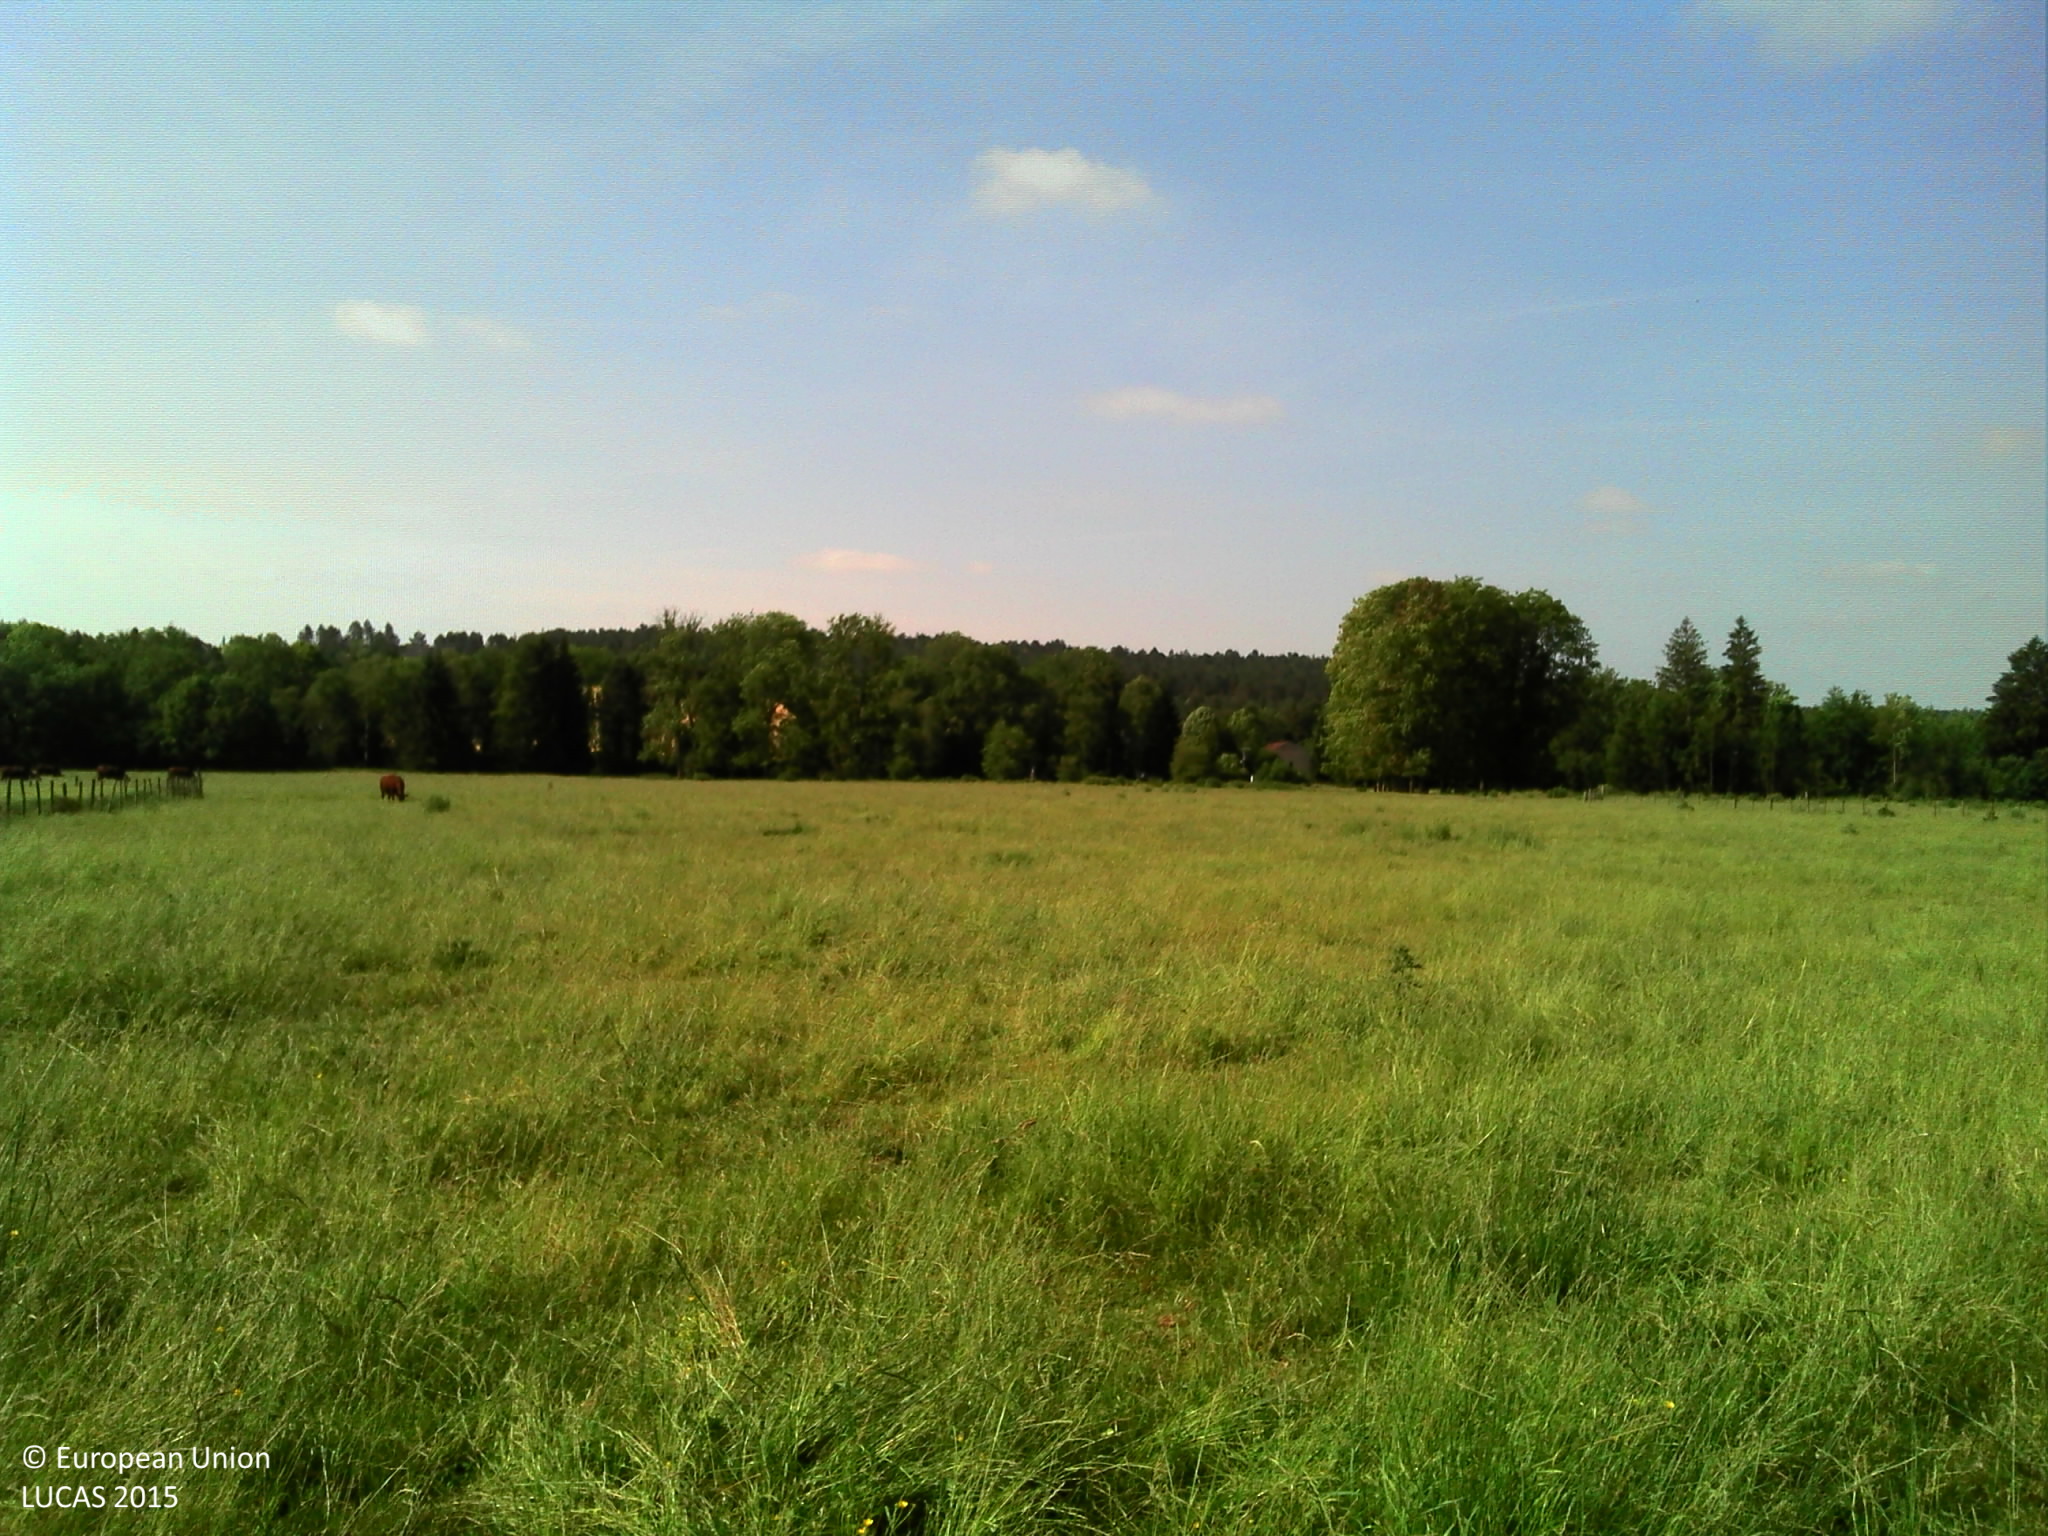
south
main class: Grassland
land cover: Grassland without tree/shrub cover
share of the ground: > 75 %
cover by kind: herbaceous plants 95 %, shrubs 5 %
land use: Agriculture (excluding fallow land and kitchen gardens)
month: June
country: FR
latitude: 47.5196
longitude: 5.0998
